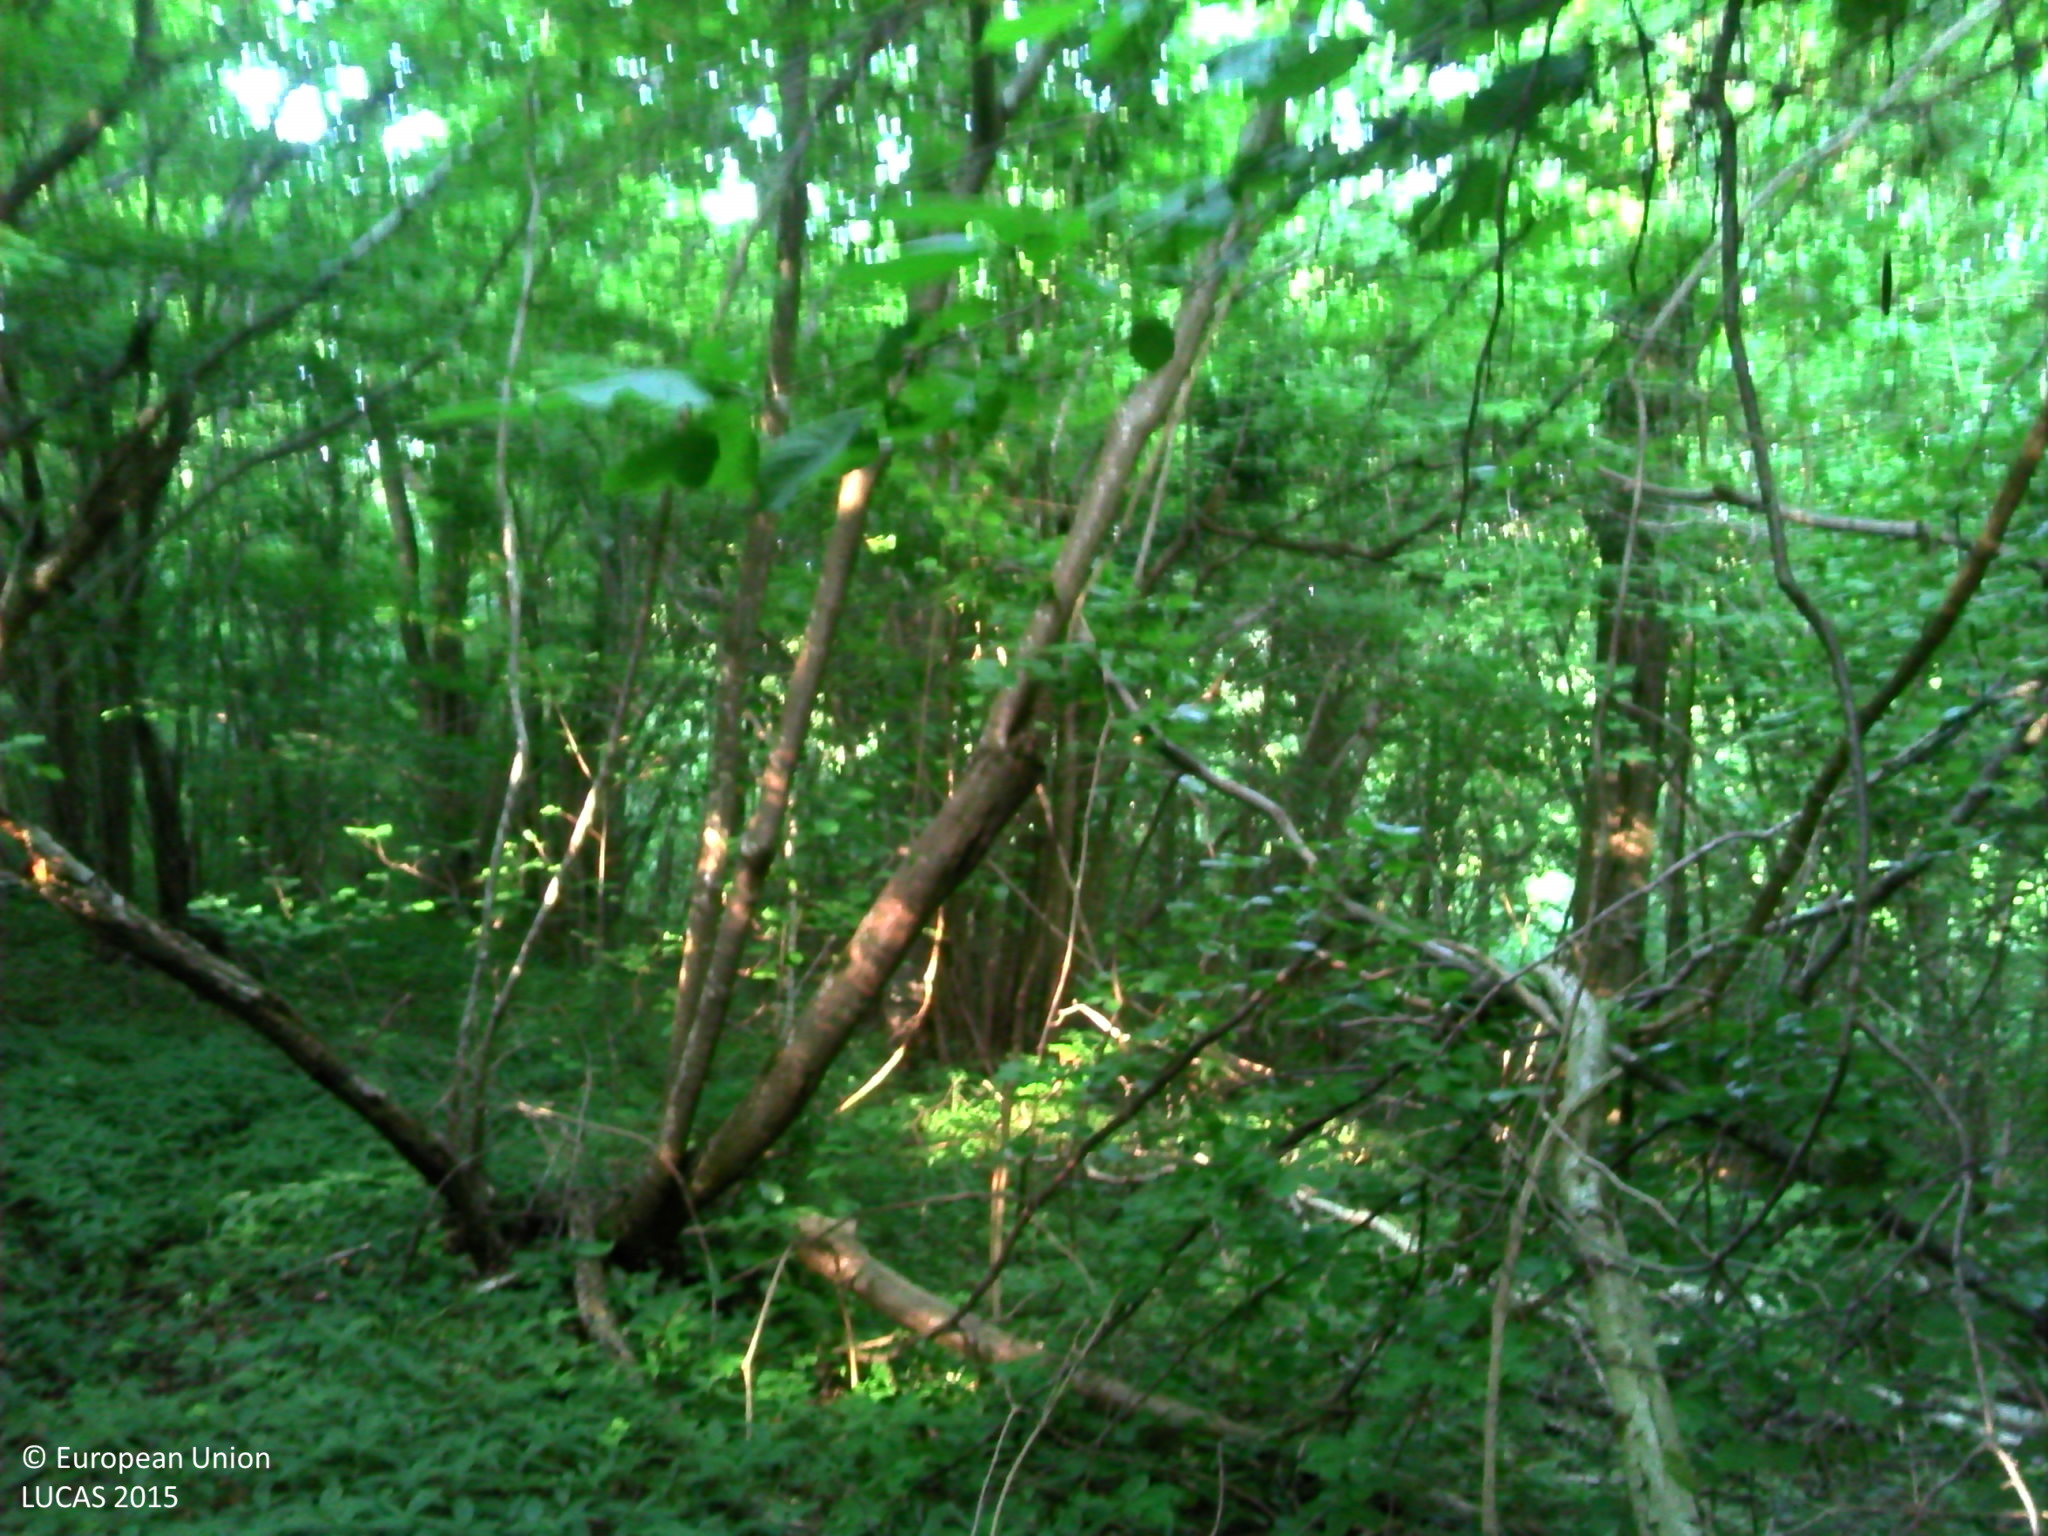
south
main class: Woodland
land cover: Broadleaved woodland
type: mesophytic deciduous forest
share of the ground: > 75 %
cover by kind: broadleaved forest trees 85 %, shrubs 10 %, herbaceous plants 5 %
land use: Forestry
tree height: > 5 m
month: June
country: FR
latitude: 49.5423
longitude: 2.8171
